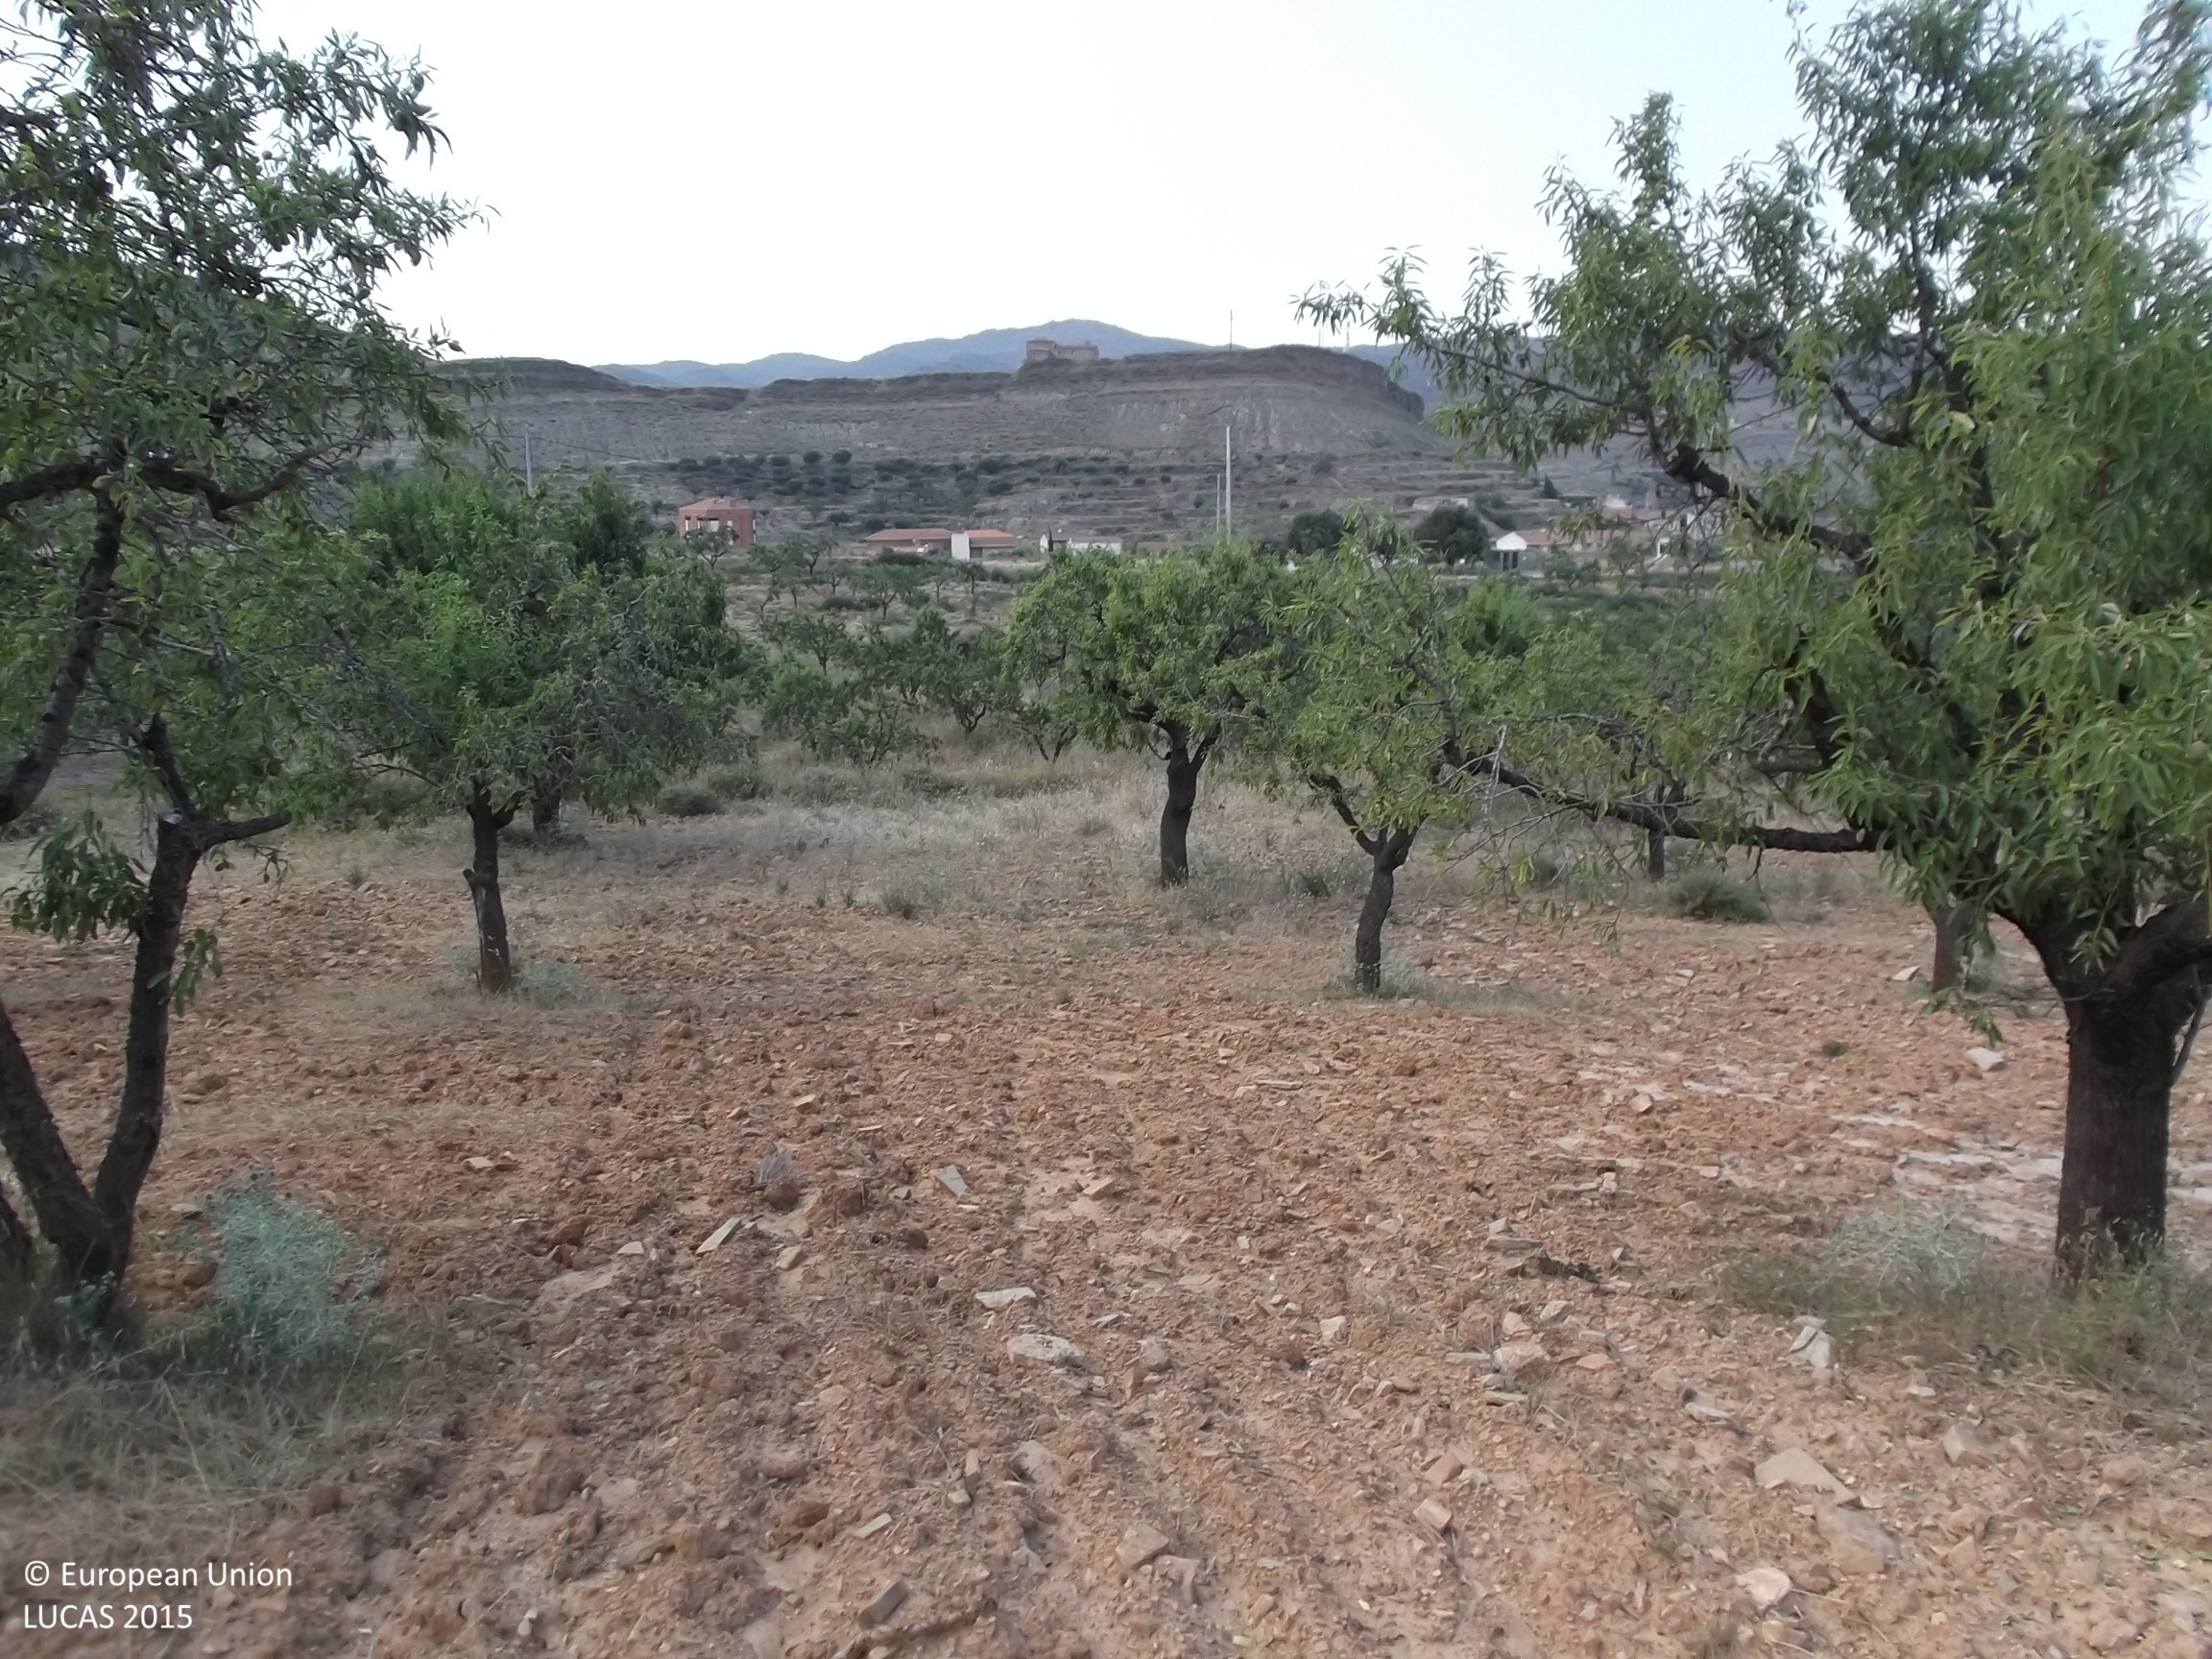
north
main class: Cropland
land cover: Nuts trees
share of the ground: 25 - 50 %
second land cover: Other bare soil
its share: > 75 %
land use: Agriculture (excluding fallow land and kitchen gardens)
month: July
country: ES
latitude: 42.0641
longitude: -2.0121
